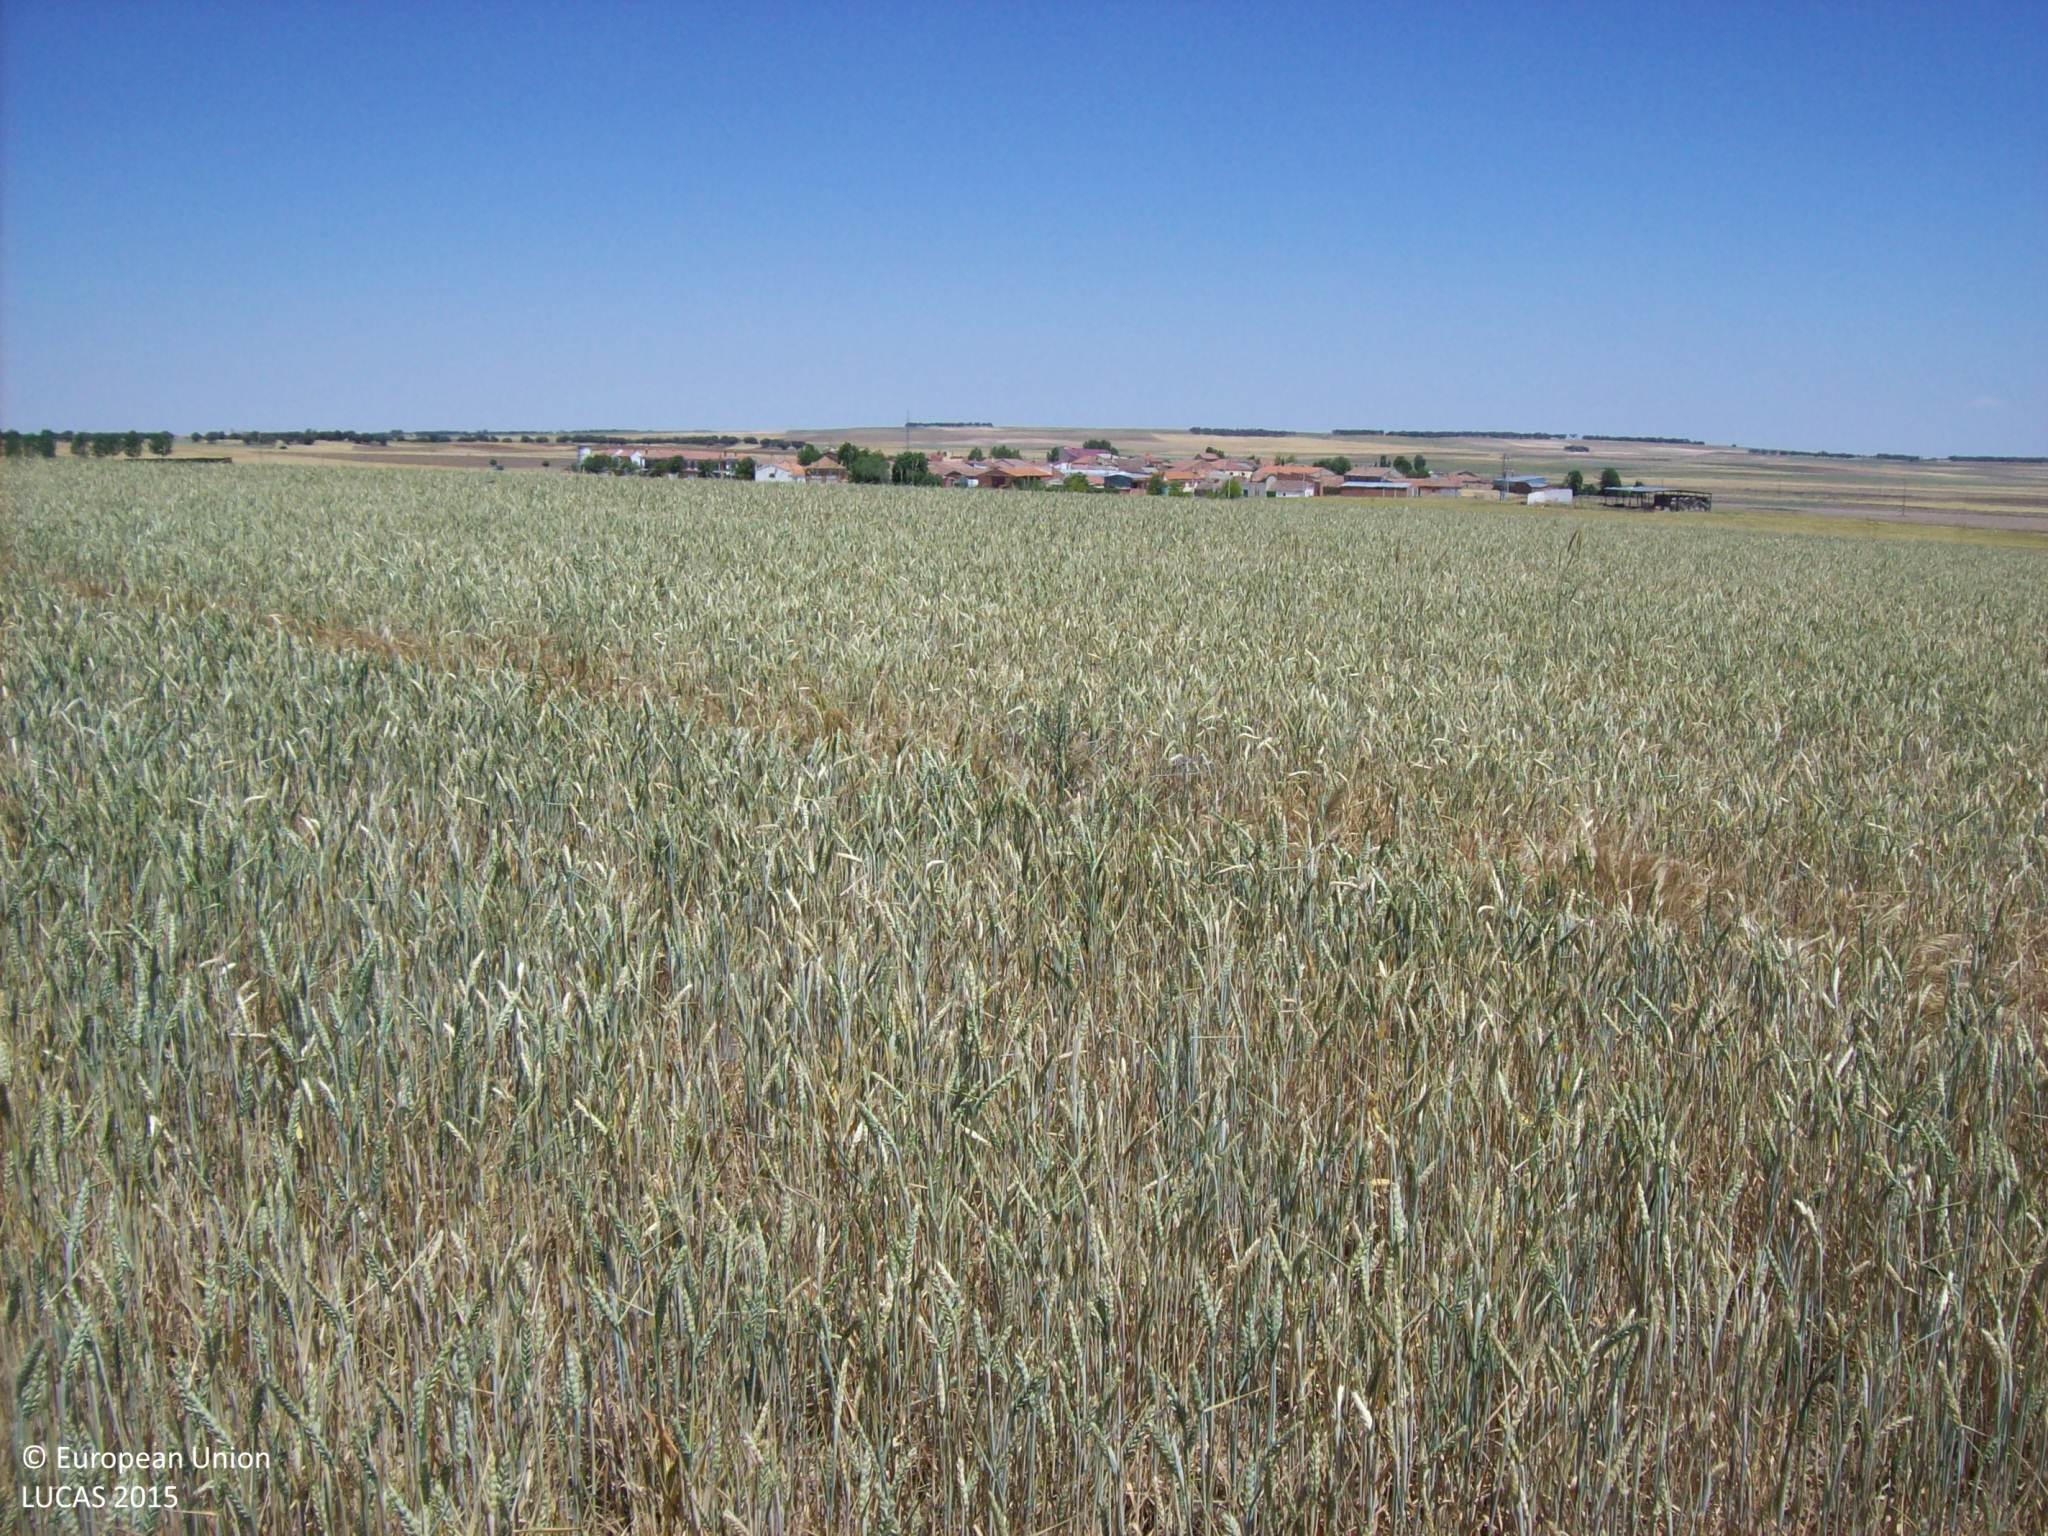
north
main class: Cropland
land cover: Common wheat
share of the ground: > 75 %
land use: Agriculture (excluding fallow land and kitchen gardens)
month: May
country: ES
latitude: 40.8443
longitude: -4.9233
